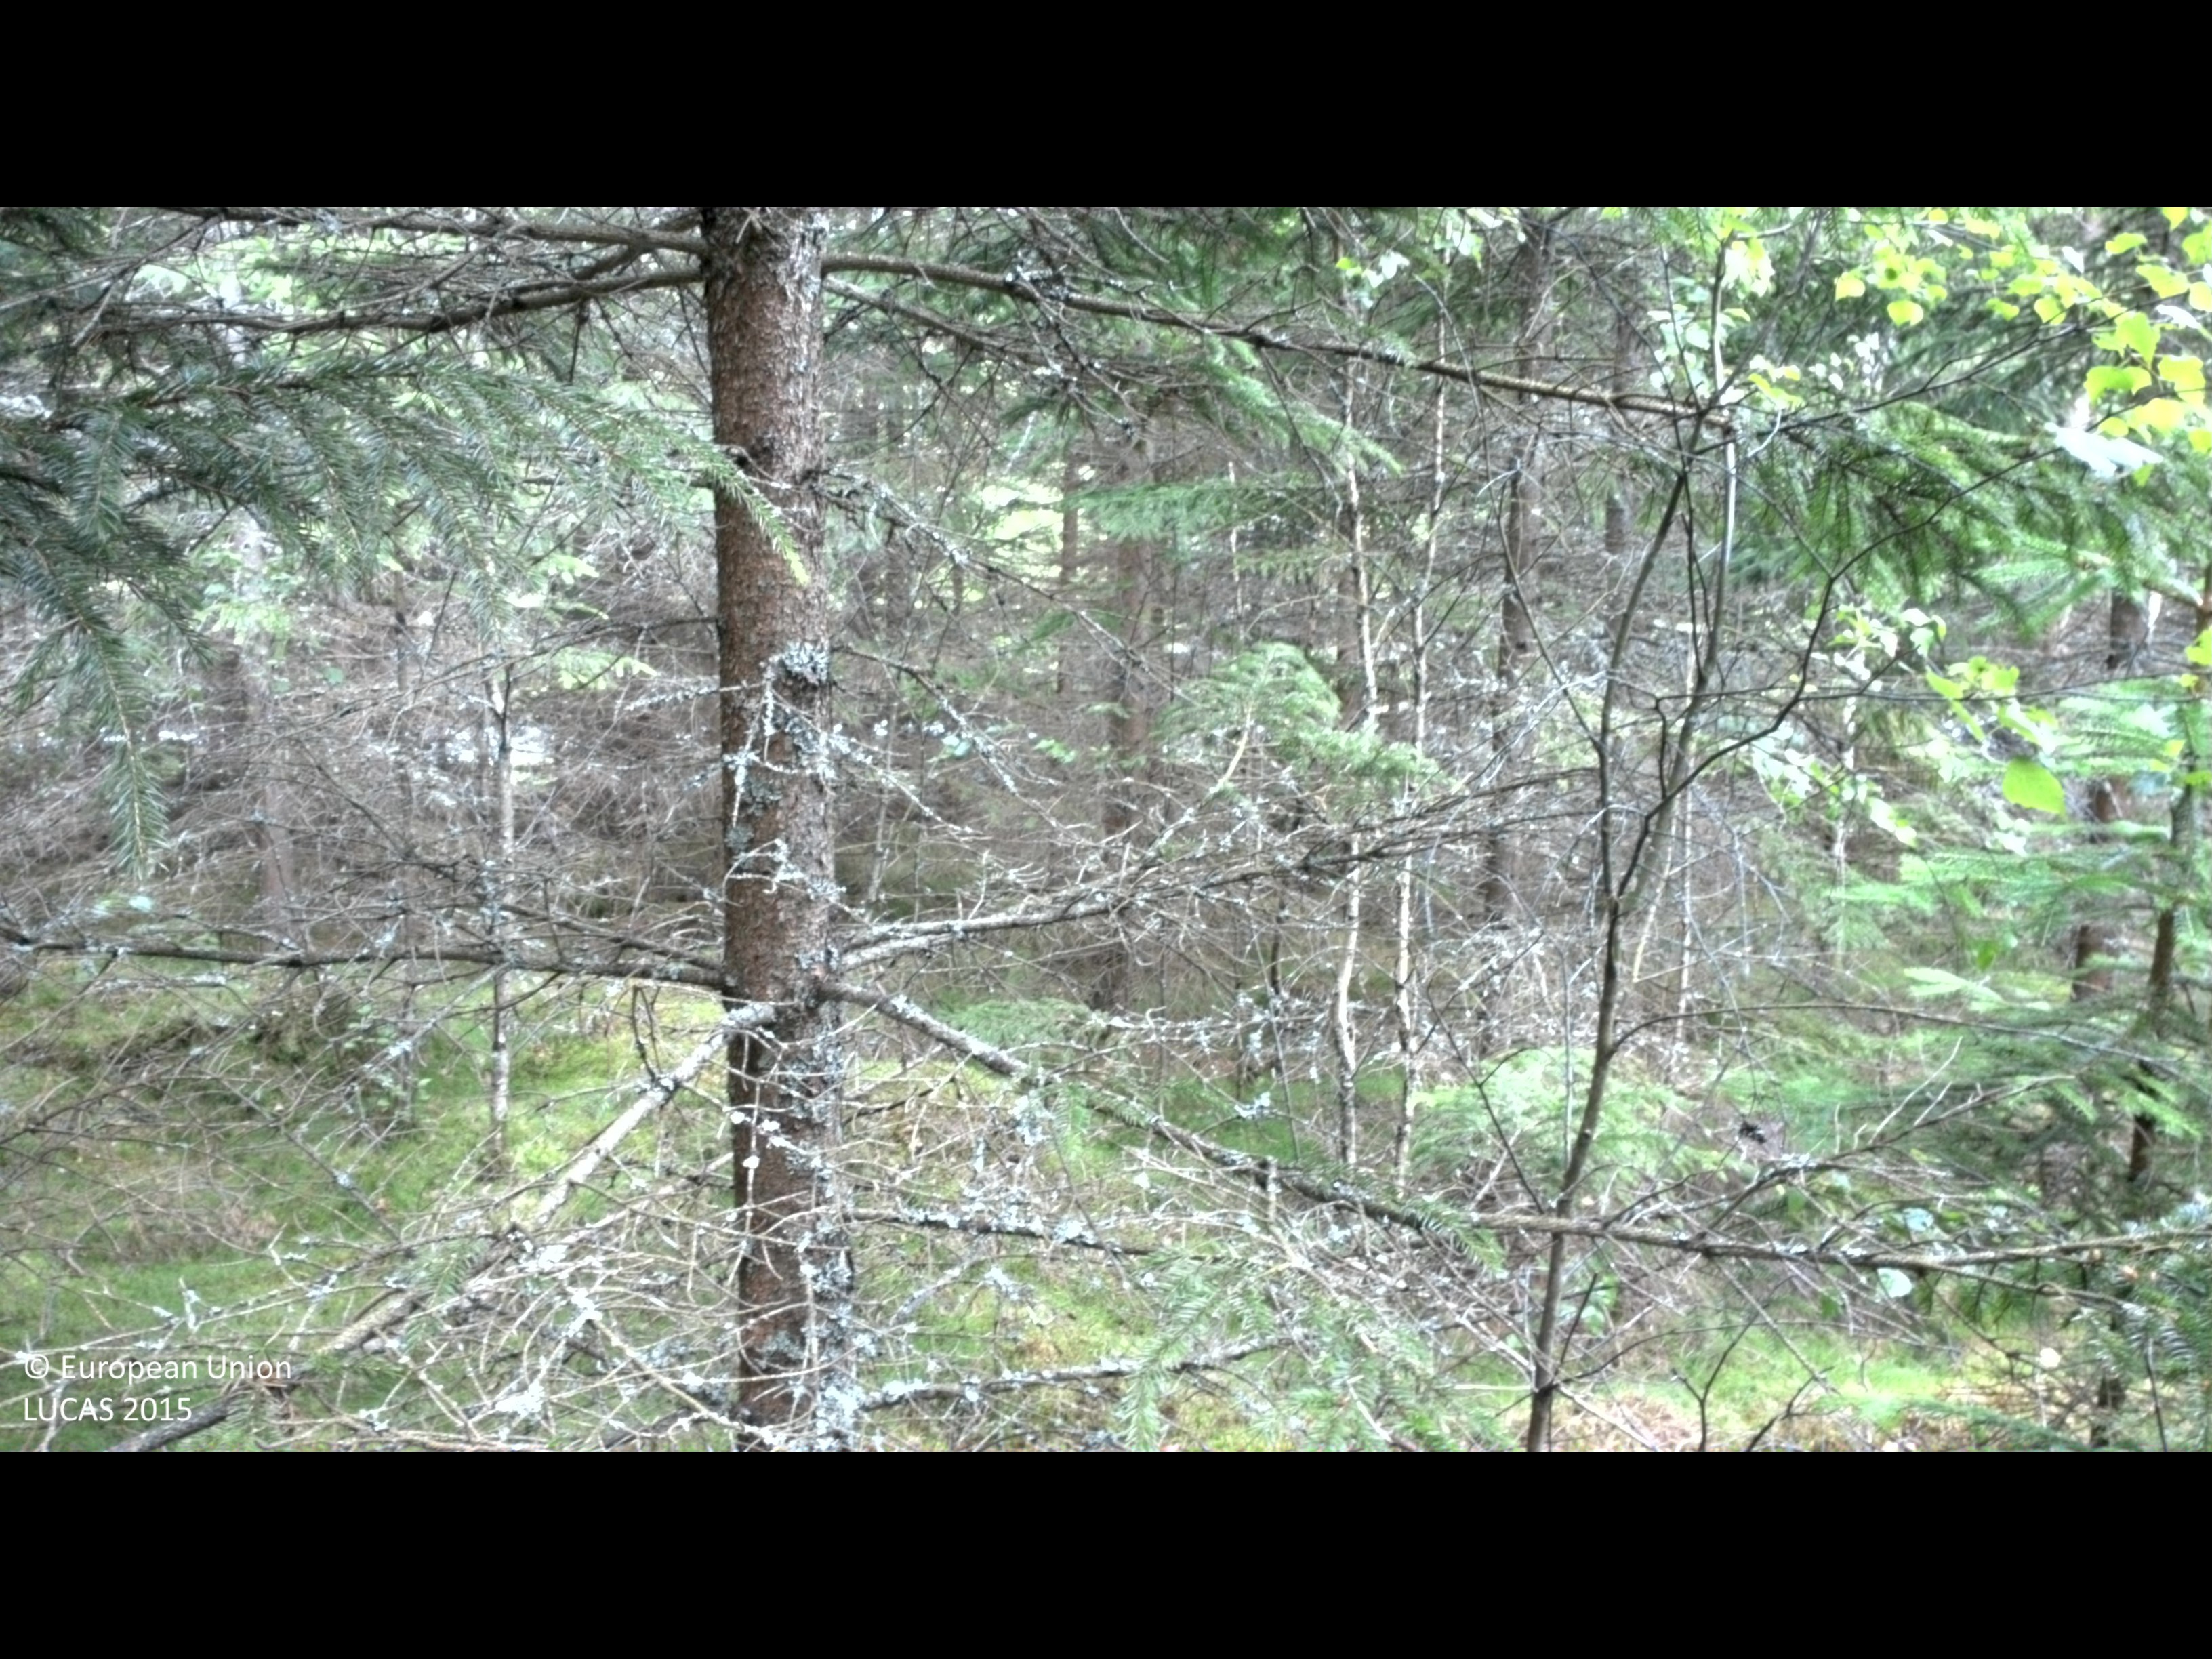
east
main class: Woodland
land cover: Spruce dominated coniferous woodland
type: boreal forest
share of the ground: > 75 %
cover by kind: coniferous forest trees 80 %, broadleaved forest trees 10 %, lichens and mosses 10 %
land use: Forestry
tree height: > 5 m
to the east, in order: Spruce dominated coniferous woodland; Paved roads, cycling and walking lanes; Spruce dominated coniferous woodland; Broadleaved woodland
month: July
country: SE
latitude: 56.4601
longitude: 14.2329
